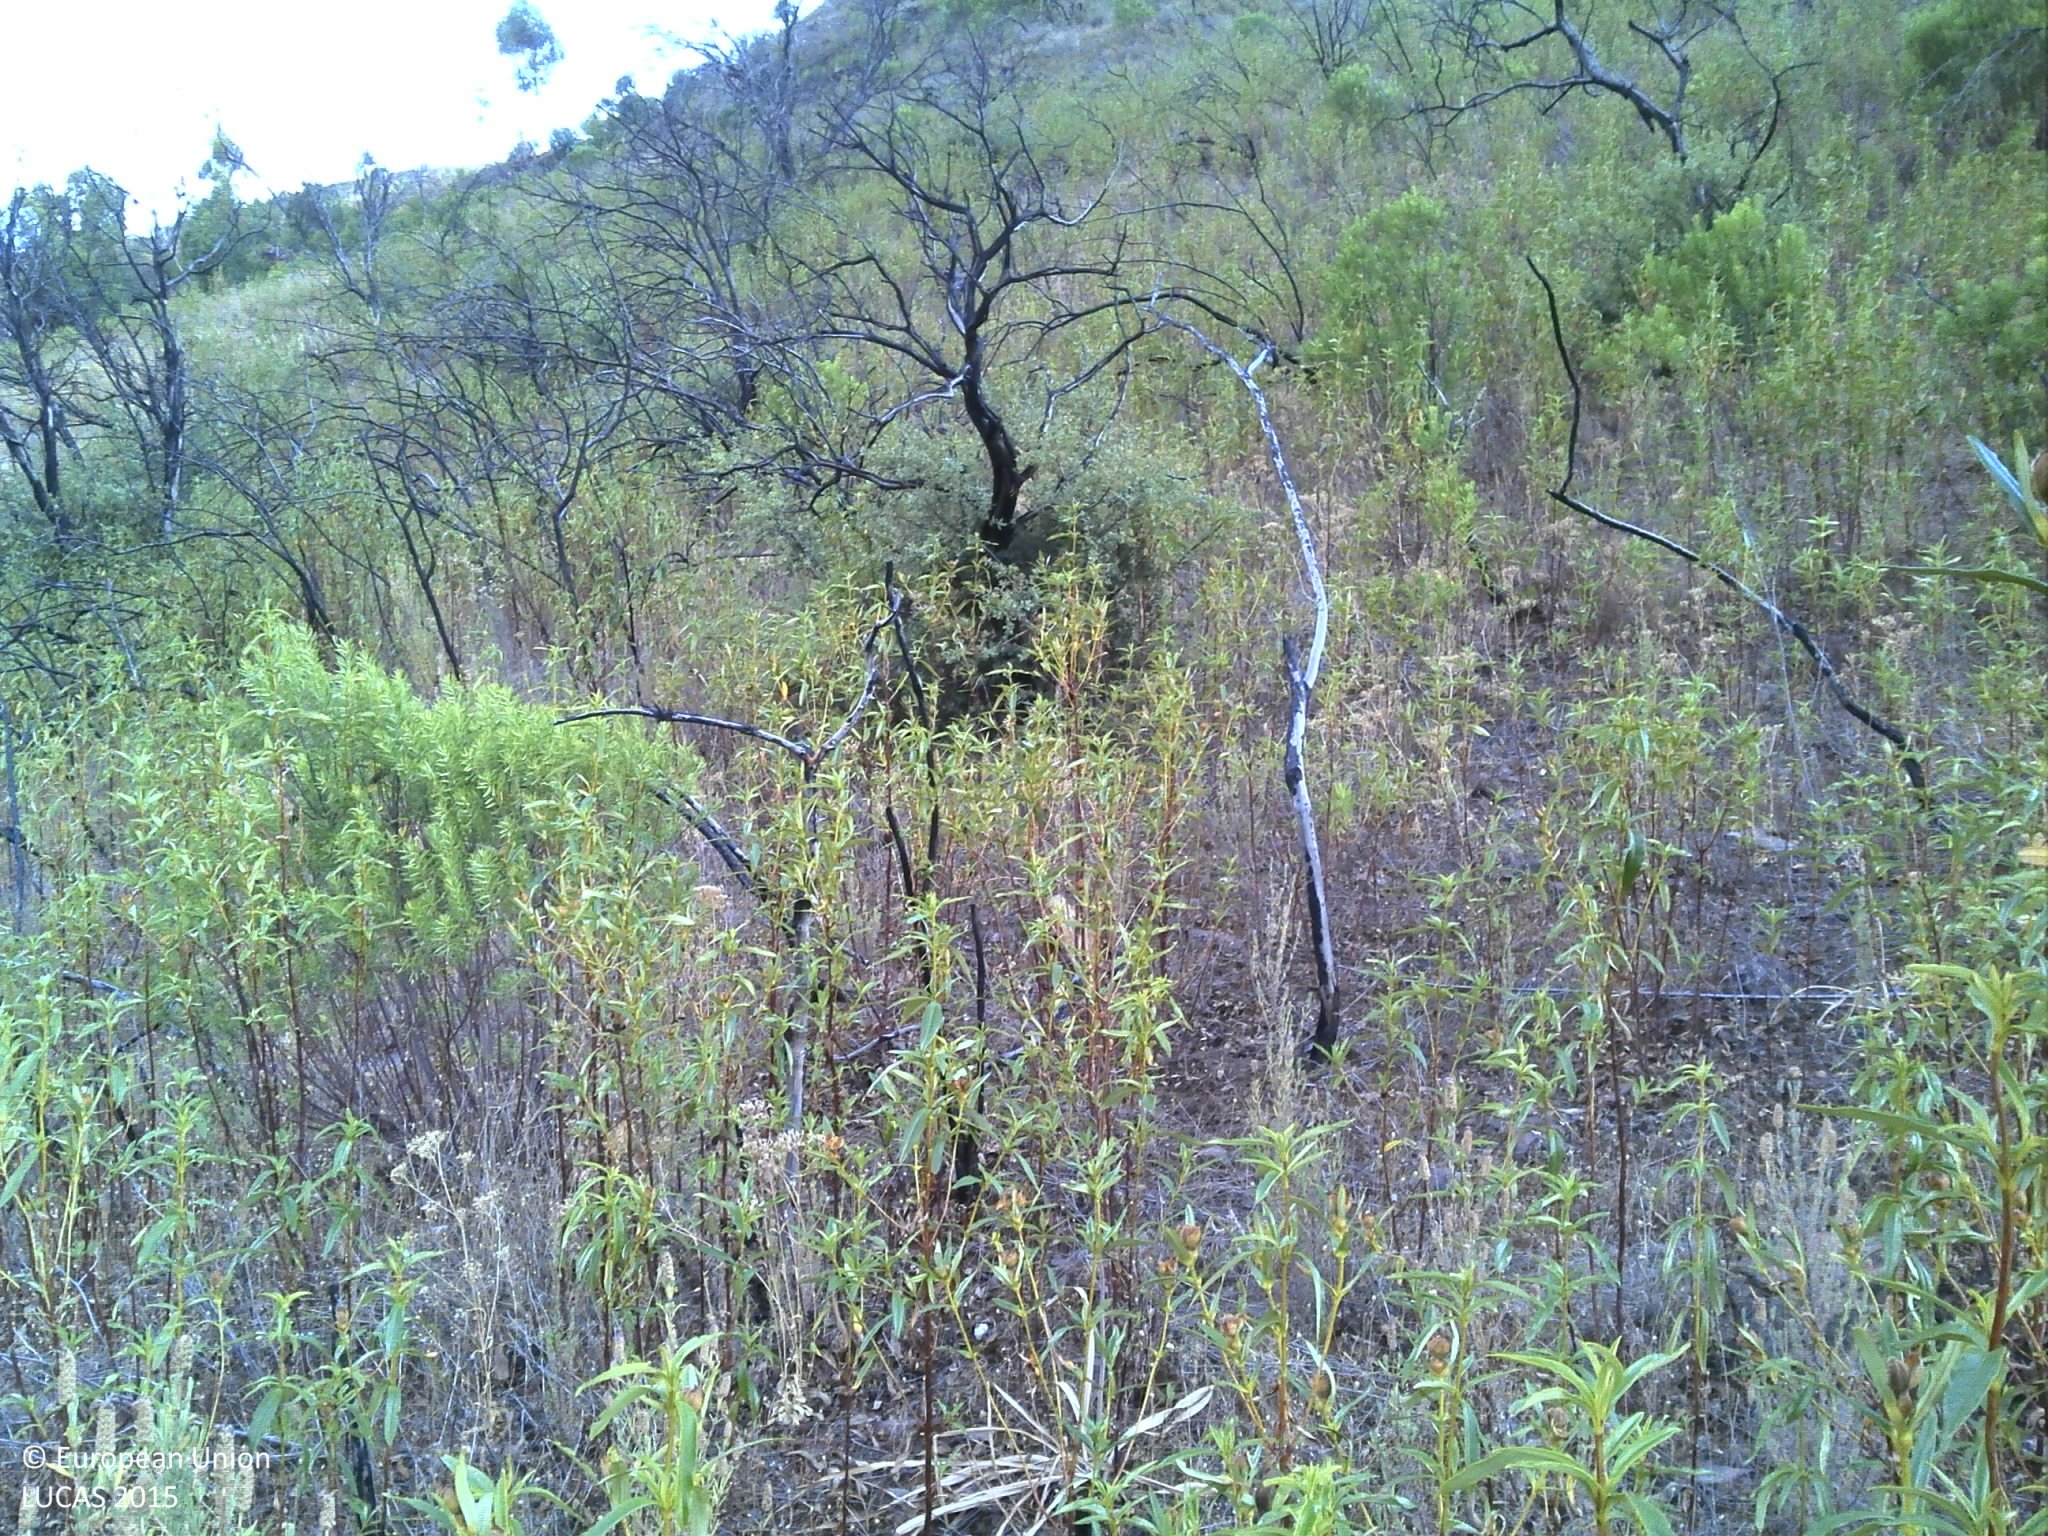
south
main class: Shrubland
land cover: Shrubland without tree cover
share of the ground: 50 - 75 %
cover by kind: shrubs 90 %, herbaceous plants 5 %, unconsolidated bare surface 5 %
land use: Abandoned areas
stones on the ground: < 10 %
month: June
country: PT
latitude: 37.2396
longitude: -7.6946
